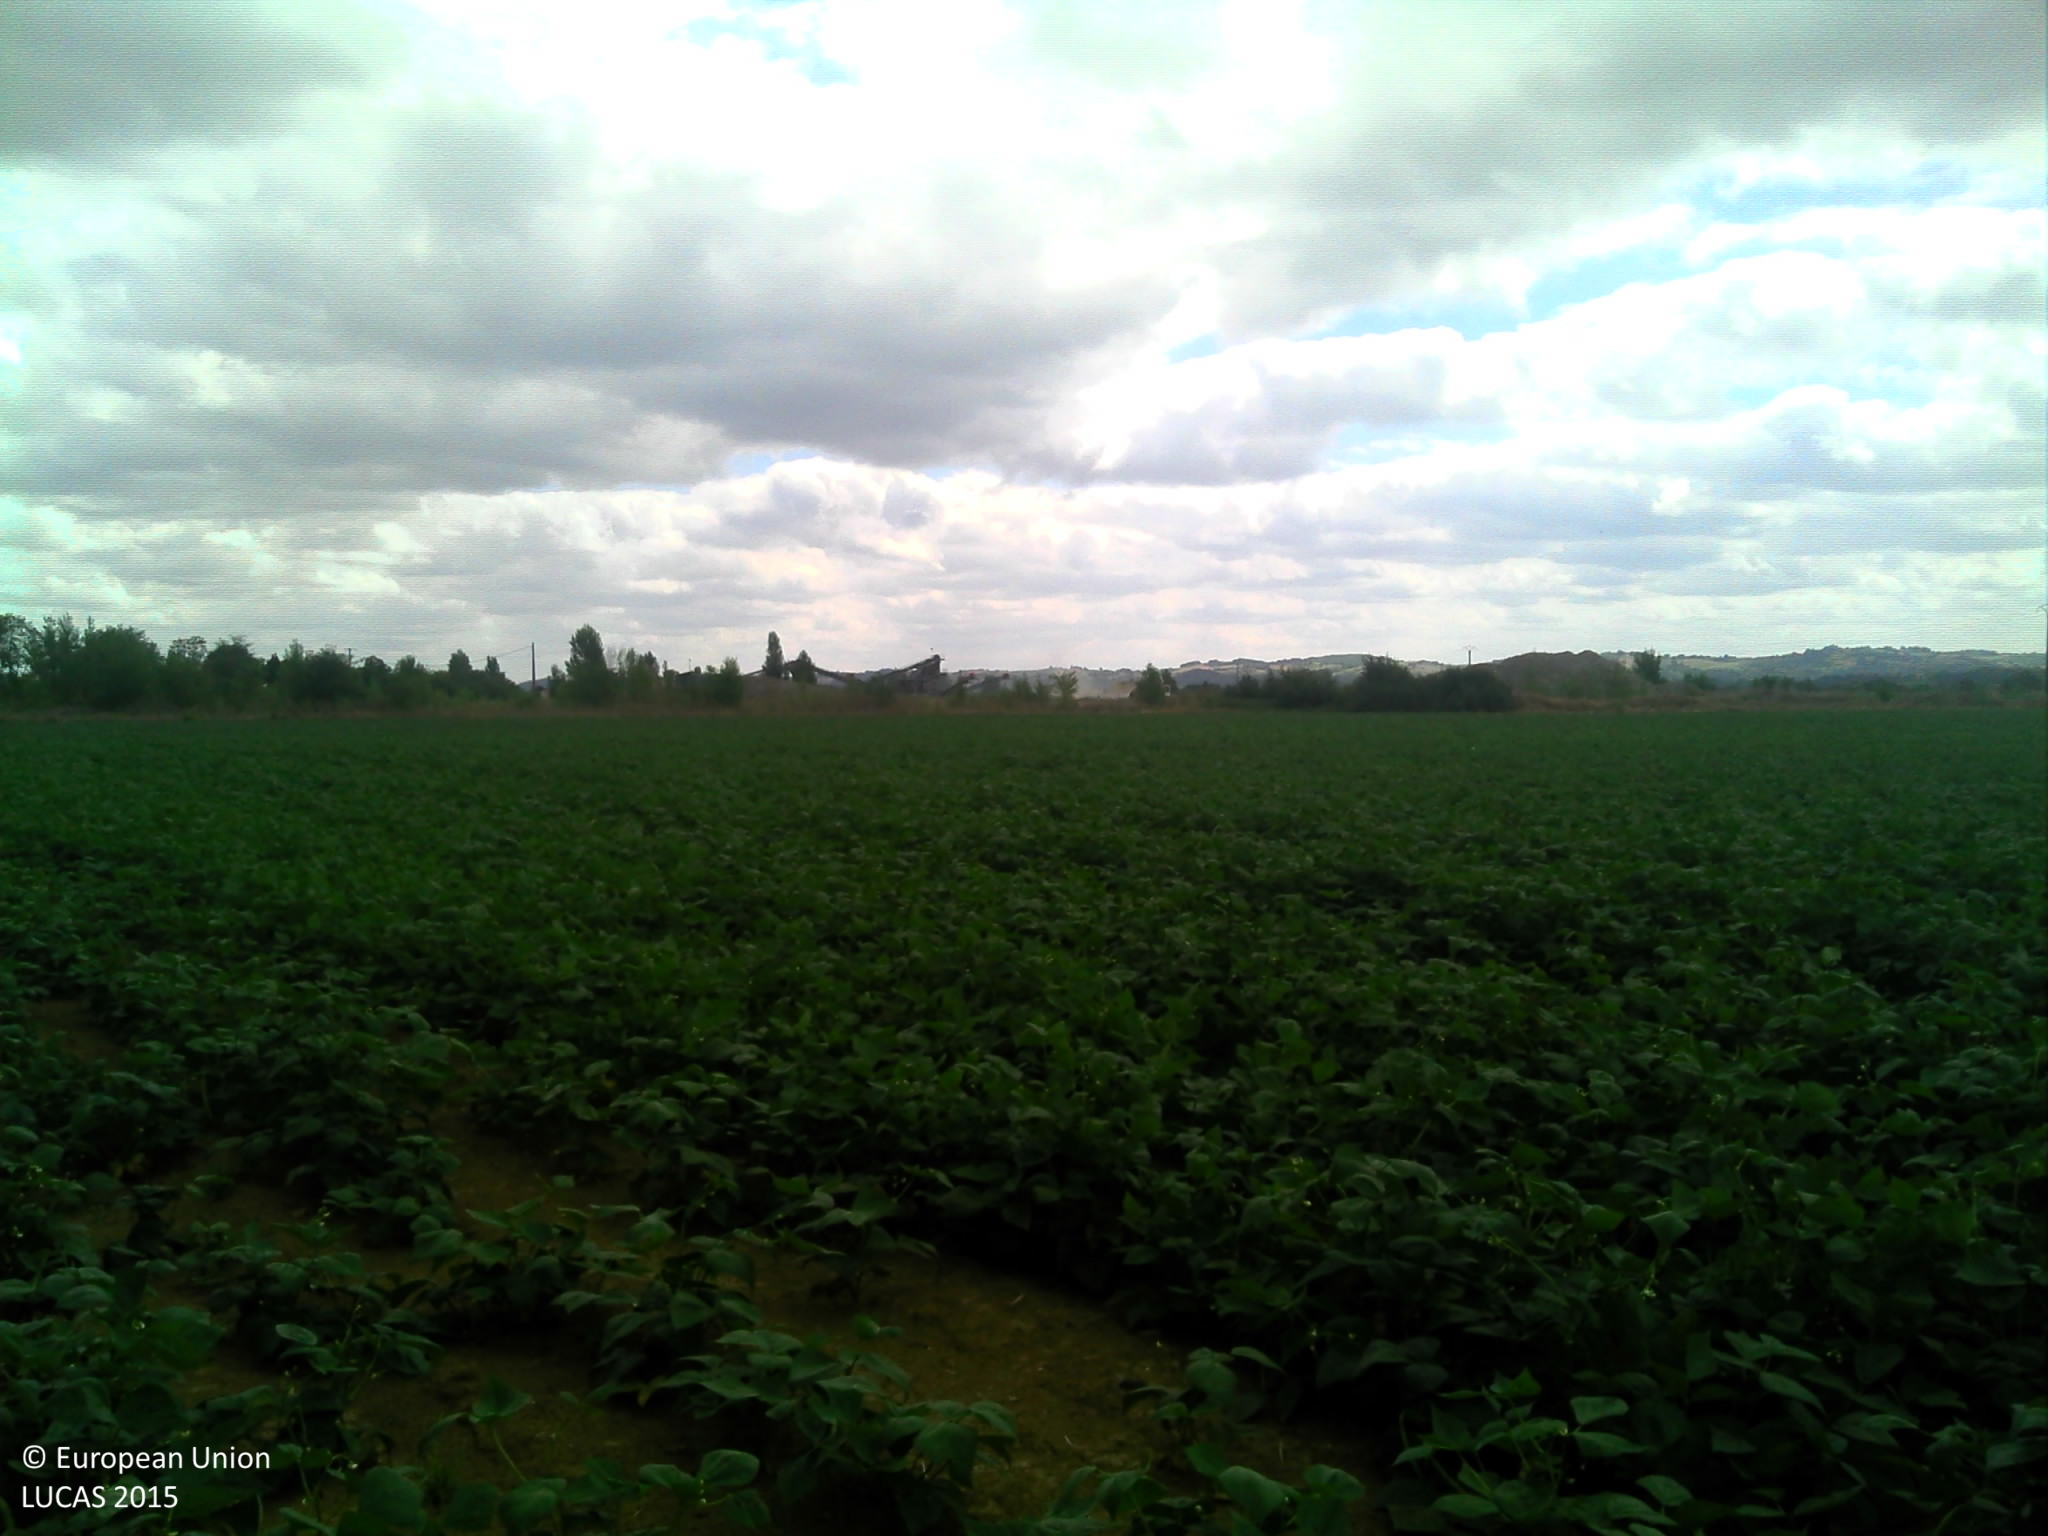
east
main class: Cropland
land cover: Other fresh vegetables
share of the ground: > 75 %
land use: Agriculture (excluding fallow land and kitchen gardens)
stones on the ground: < 10 %
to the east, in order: Other fresh vegetables; Spontaneously vegetated surfaces; Inland fresh water bodies; Spontaneously vegetated surfaces; Inland fresh water bodies; Spontaneously vegetated surfaces; Fences; Spontaneously vegetated surfaces
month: July
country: FR
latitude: 43.2196
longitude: 1.0531
